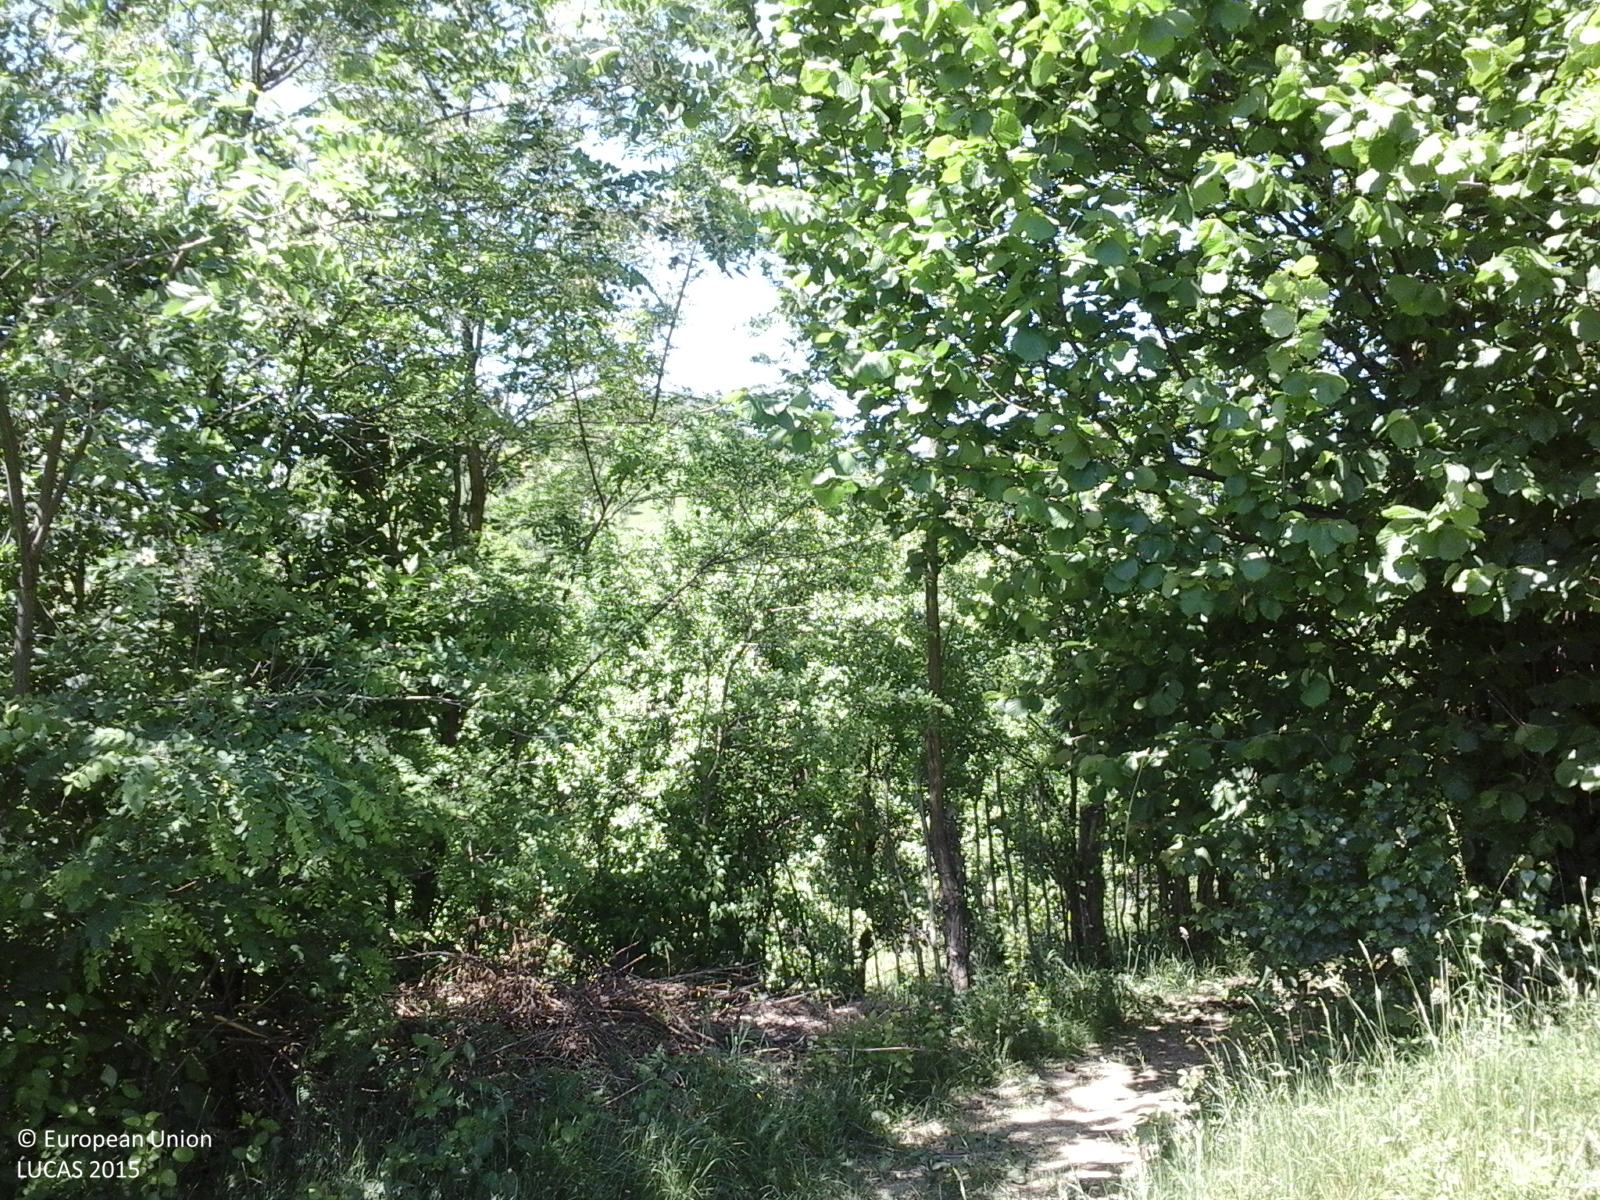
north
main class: Grassland
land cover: Grassland with sparse tree/shrub cover
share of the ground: > 75 %
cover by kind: herbaceous plants 85 %, shrubs 10 %, broadleaved forest trees 5 %
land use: Agriculture (excluding fallow land and kitchen gardens)
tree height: > 5 m
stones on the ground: < 10 %
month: June
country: RO
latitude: 45.2113
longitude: 25.7528
